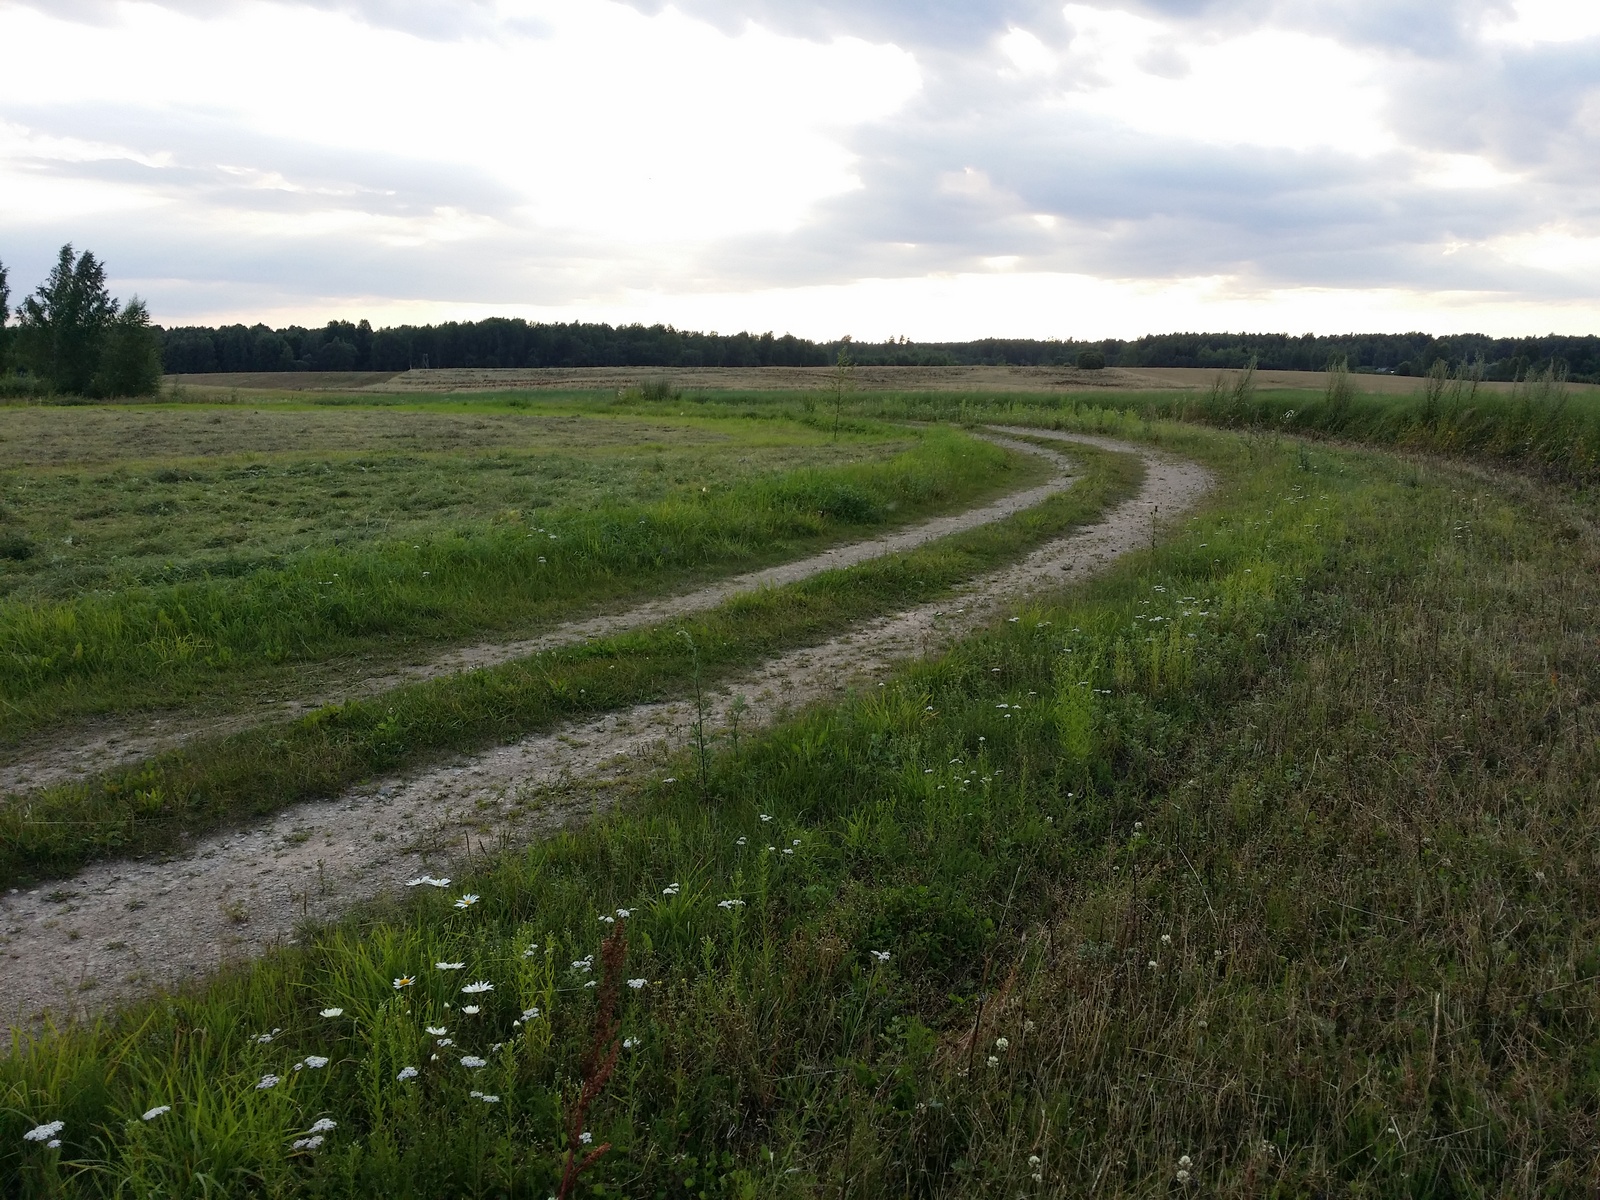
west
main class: Cropland
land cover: Rape and turnip rape
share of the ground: > 75 %
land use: Agriculture (excluding fallow land and kitchen gardens)
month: August
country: LV
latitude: 57.3749
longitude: 26.6278
